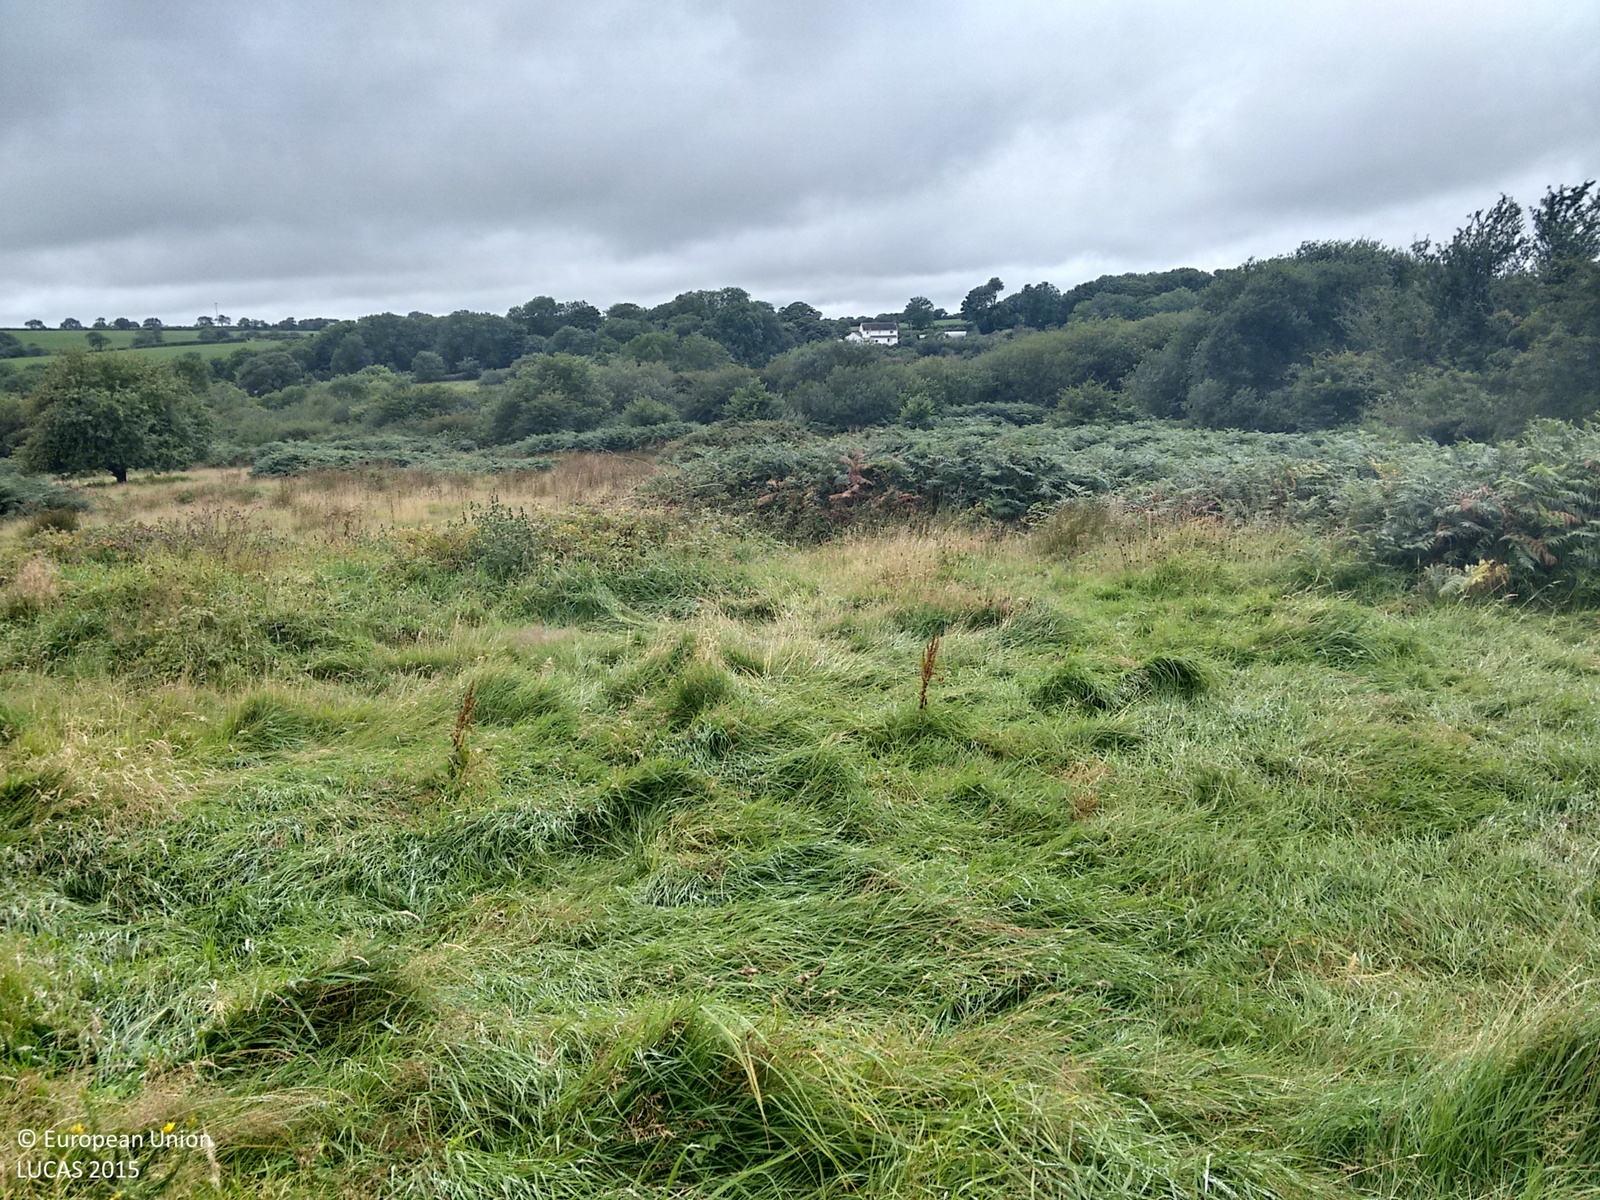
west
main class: Shrubland
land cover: Shrubland with sparse tree cover
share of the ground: > 75 %
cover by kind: herbaceous plants 65 %, shrubs 30 %, broadleaved forest trees 5 %
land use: Agriculture (excluding fallow land and kitchen gardens)
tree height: < 5 m
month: August
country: GB
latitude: 51.7625
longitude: -4.7302
